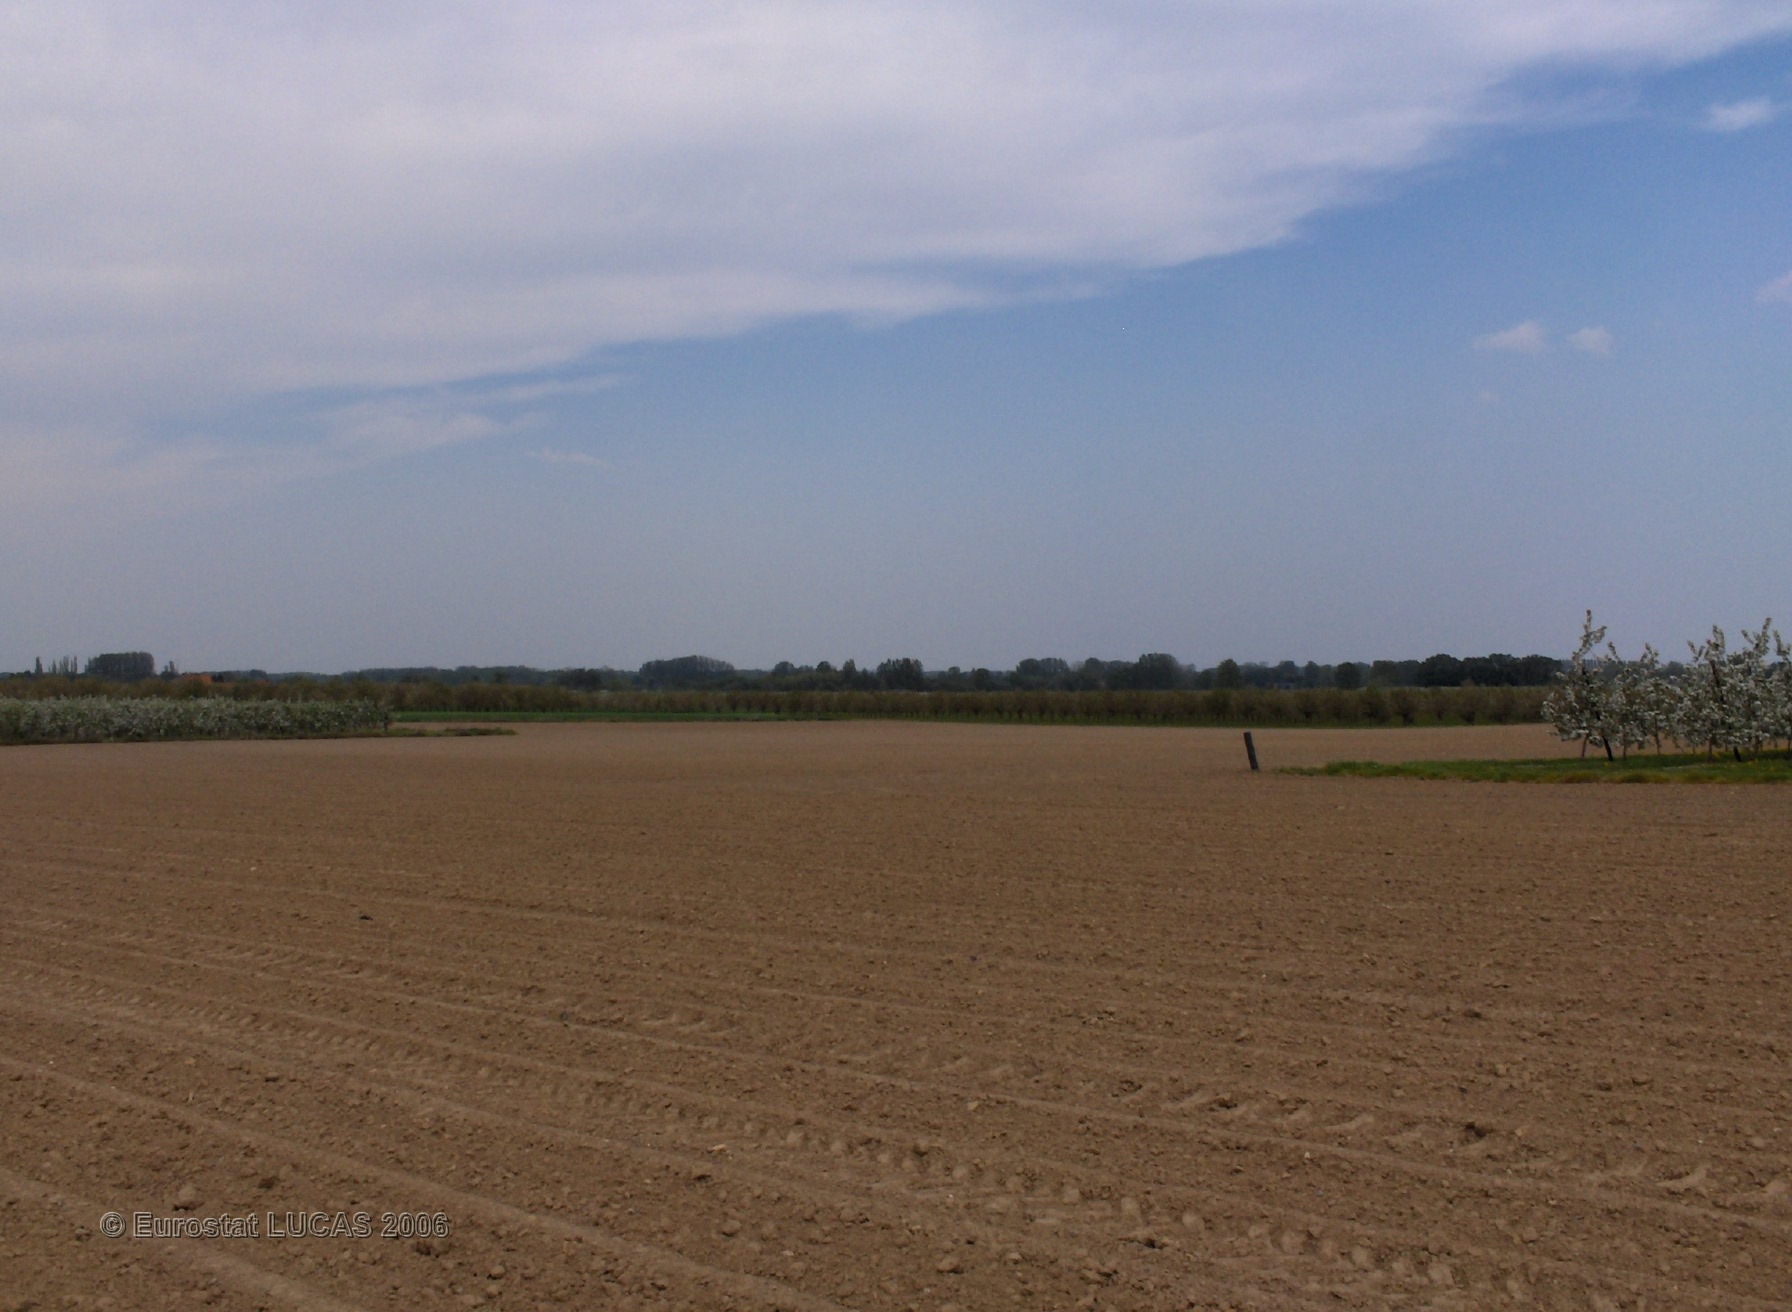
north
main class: Cropland
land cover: Maize
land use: Agriculture (excluding fallow land and kitchen gardens)
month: May
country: BE
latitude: 50.9120
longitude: 5.2045
